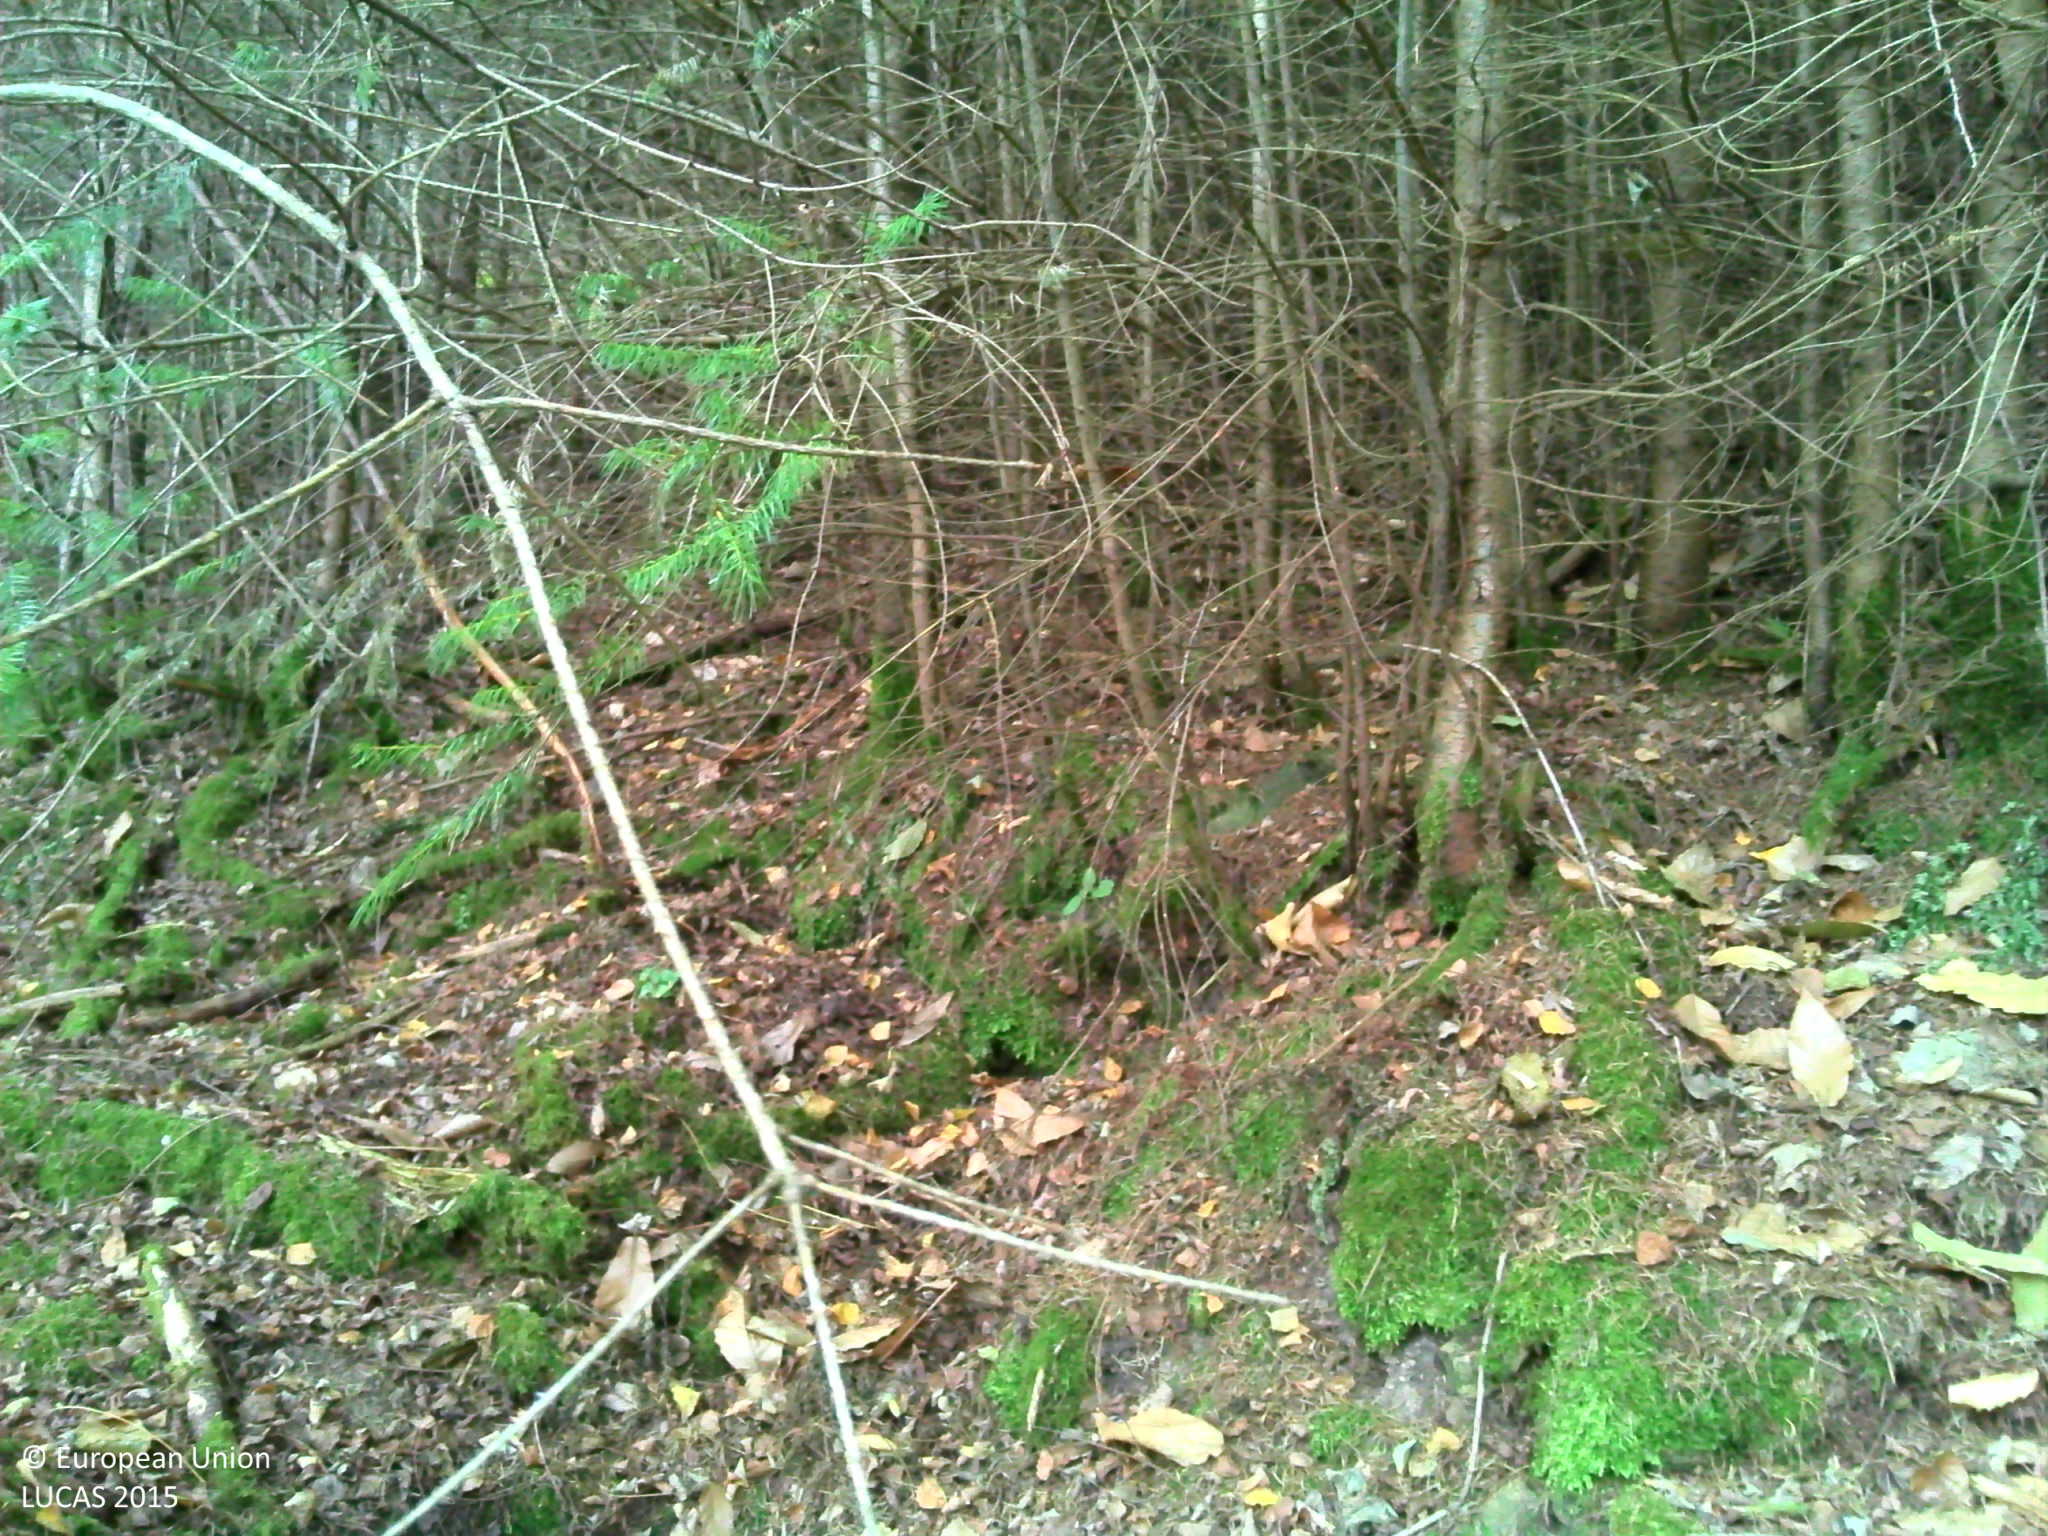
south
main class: Woodland
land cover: Spruce dominated mixed woodland
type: mesophytic deciduous forest
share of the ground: > 75 %
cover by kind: coniferous forest trees 40 %, broadleaved forest trees 30 %, herbaceous plants 20 %, lichens and mosses 10 %
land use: Forestry
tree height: > 5 m
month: August
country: FR
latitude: 46.1595
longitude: 4.5763
